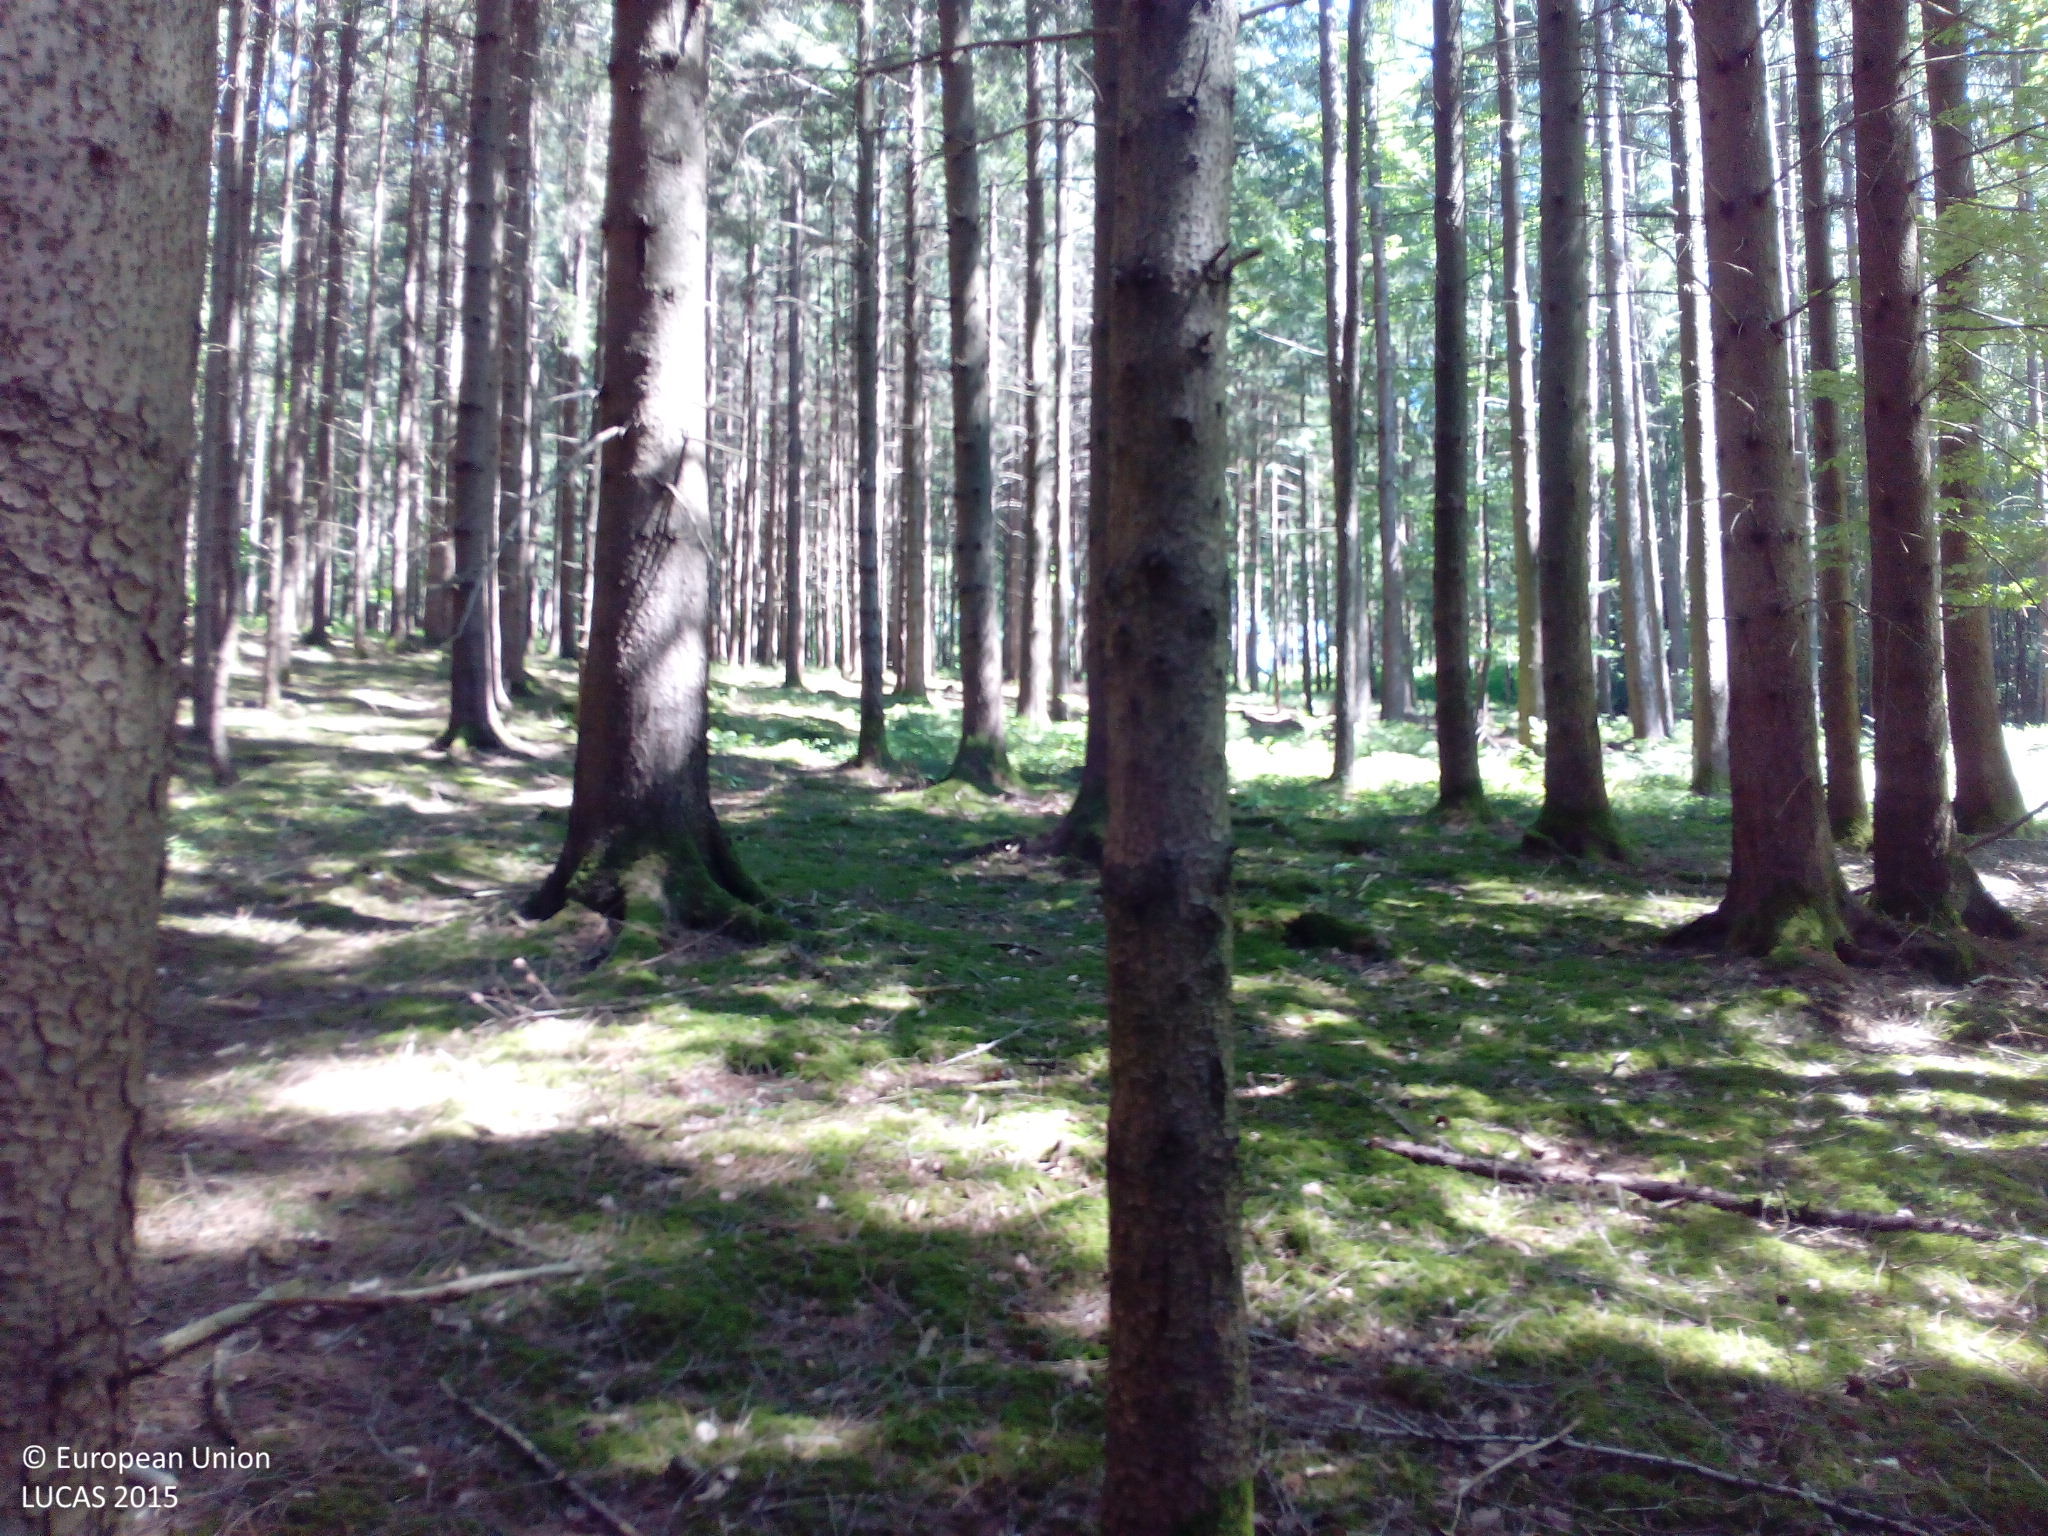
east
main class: Woodland
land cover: Spruce dominated coniferous woodland
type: hemiboreal forest and nemoral coniferous forest and mixed broadleaved-coniferous forest
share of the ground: > 75 %
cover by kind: coniferous forest trees 90 %, broadleaved forest trees 5 %, unconsolidated bare surface 5 %
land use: Forestry
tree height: > 5 m
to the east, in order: Spruce dominated coniferous woodland; Tracks; Spruce dominated coniferous woodland; Tracks; Spruce dominated mixed woodland
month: August
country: DE
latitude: 47.9540
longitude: 12.7974
